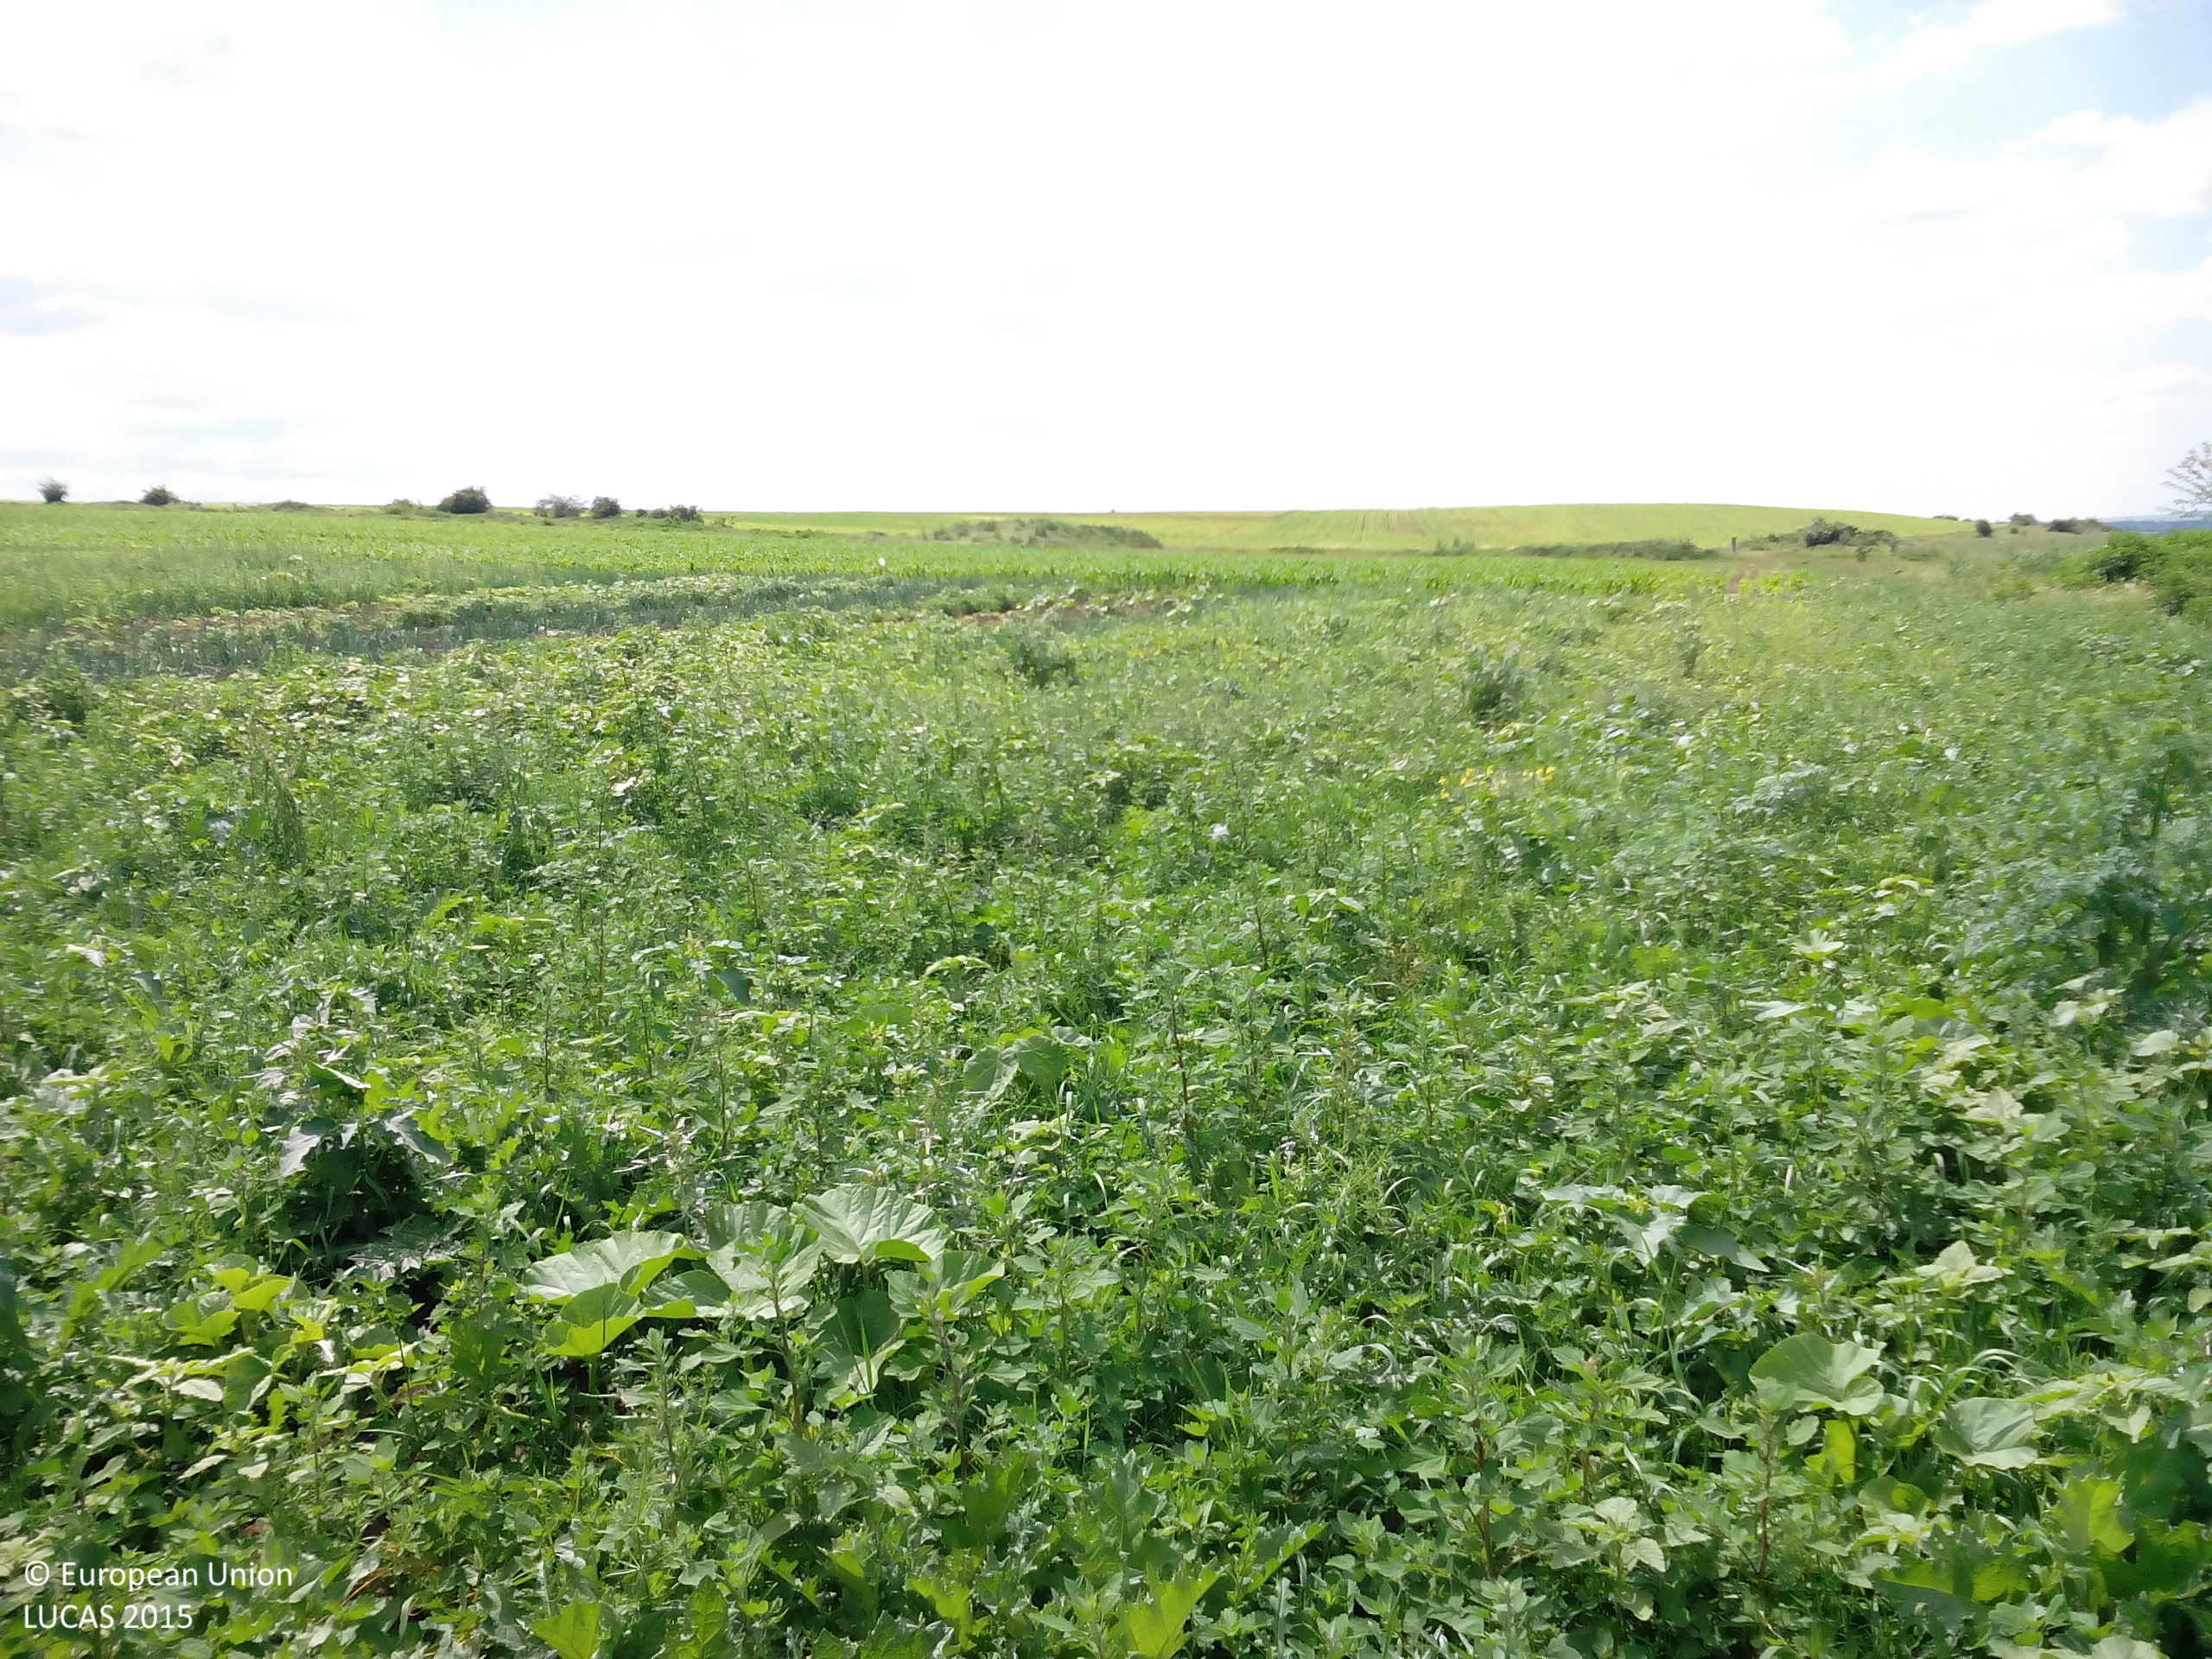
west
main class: Cropland
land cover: Cherry fruit
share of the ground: > 75 %
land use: Kitchen garden
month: May
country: BG
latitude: 43.5058
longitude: 23.8664
